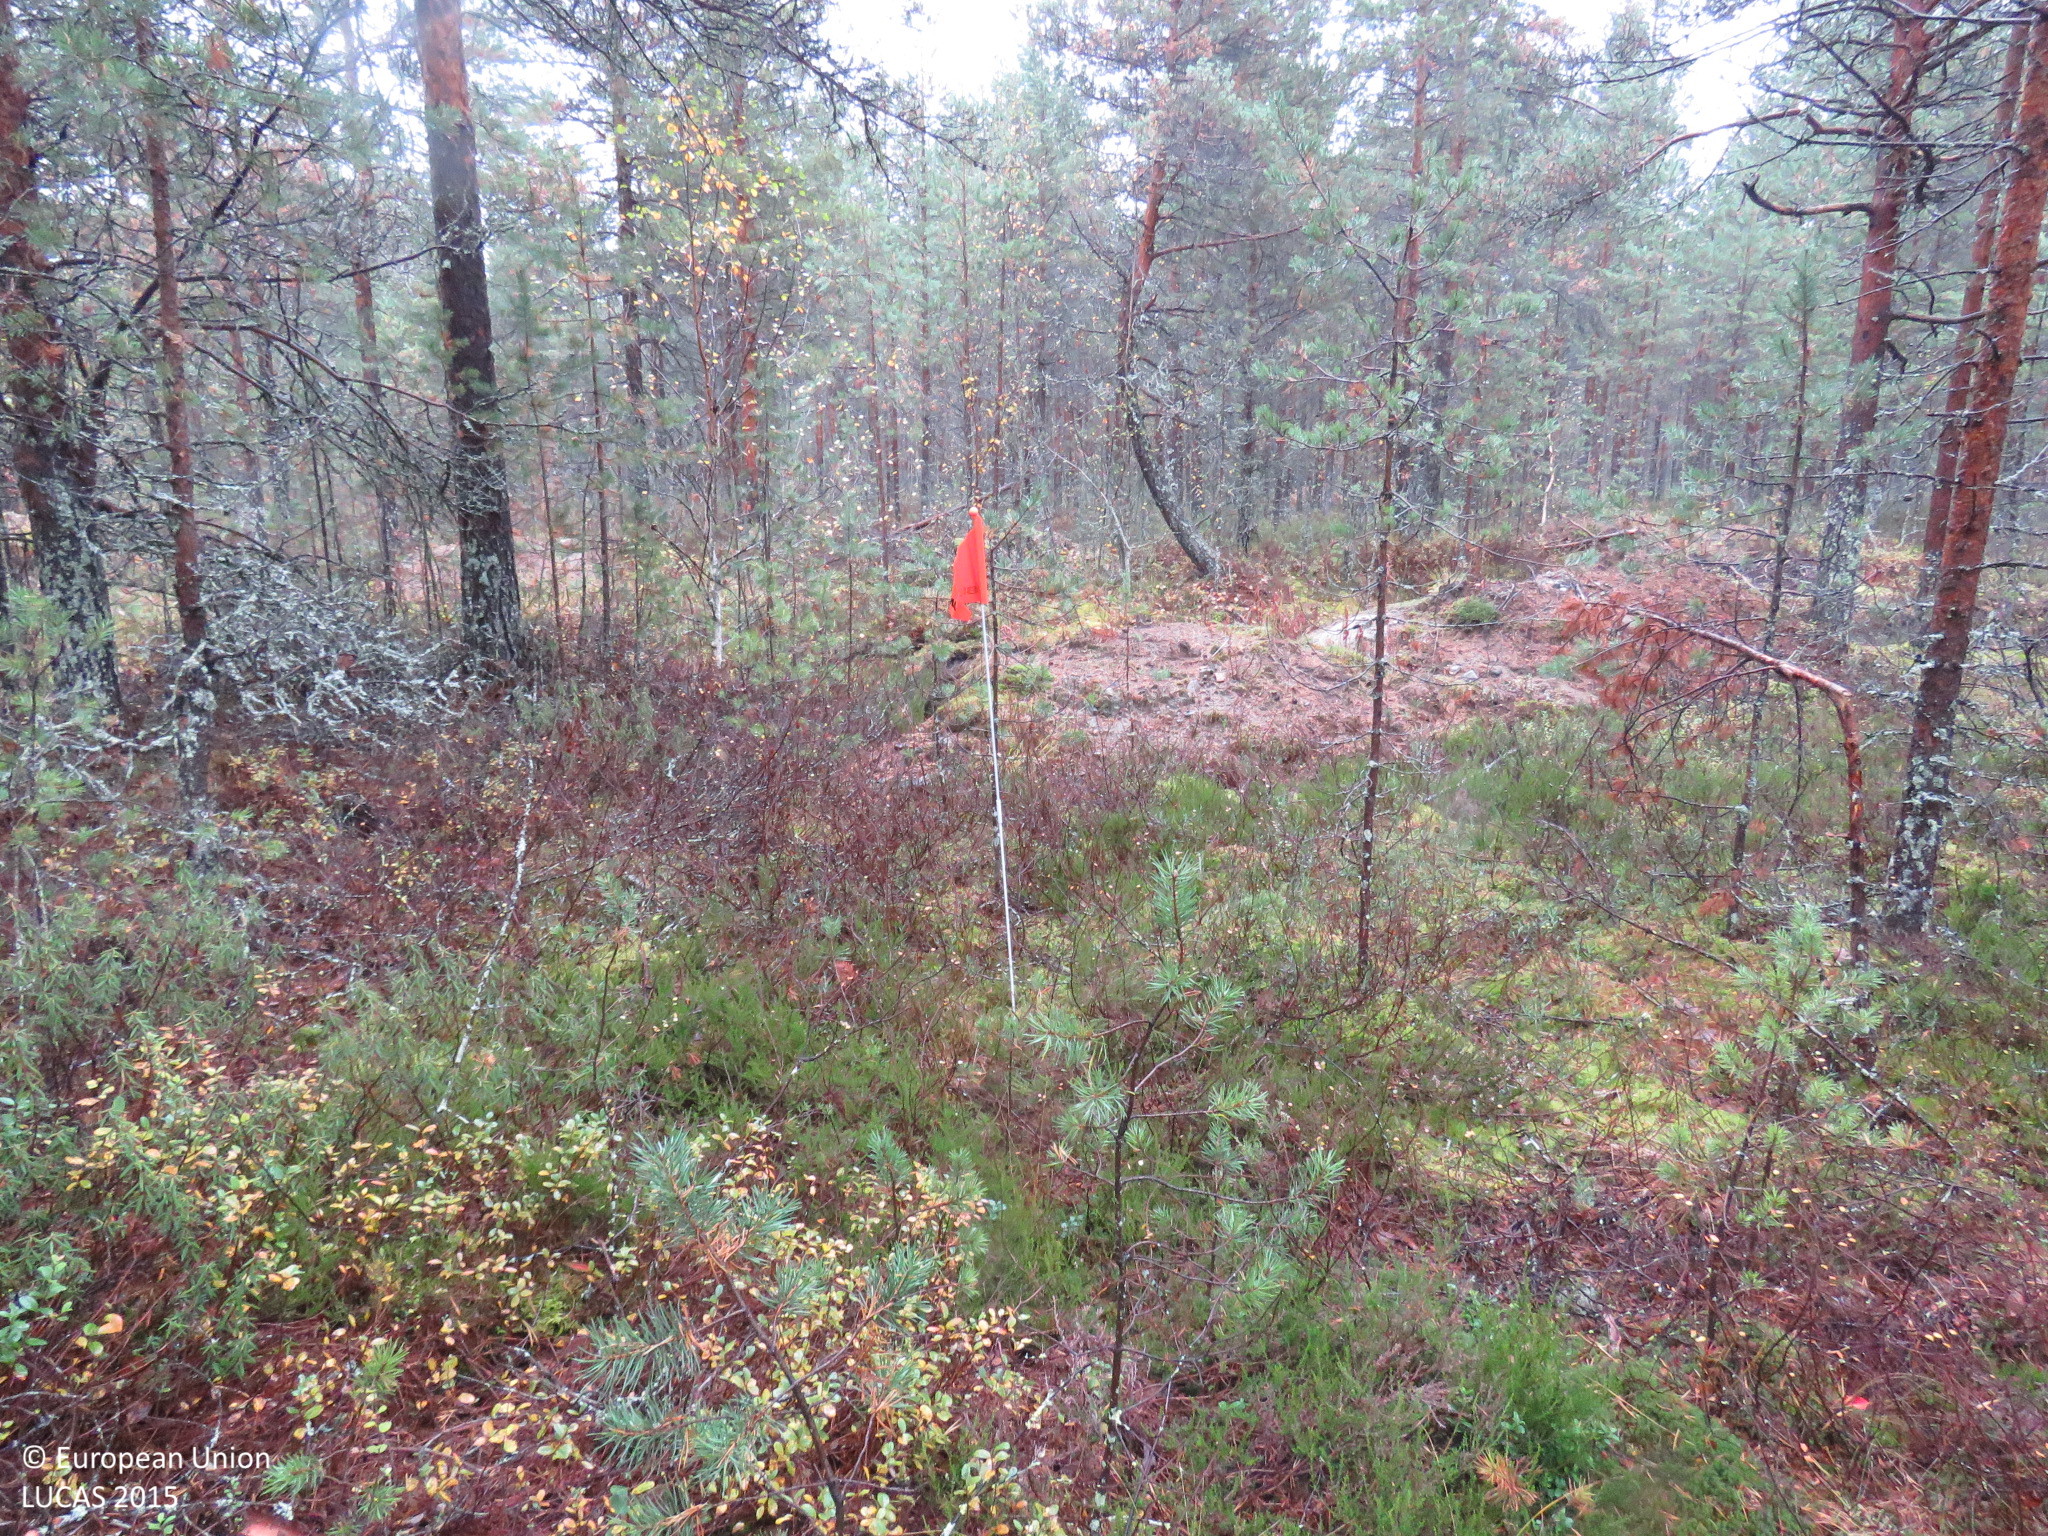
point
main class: Woodland
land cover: Pine dominated coniferous woodland
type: boreal forest
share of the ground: > 75 %
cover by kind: coniferous forest trees 70 %, shrubs 20 %, broadleaved forest trees 5 %, lichens and mosses 5 %
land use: Forestry
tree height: > 5 m
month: September
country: FI
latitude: 65.1352
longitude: 26.5407
